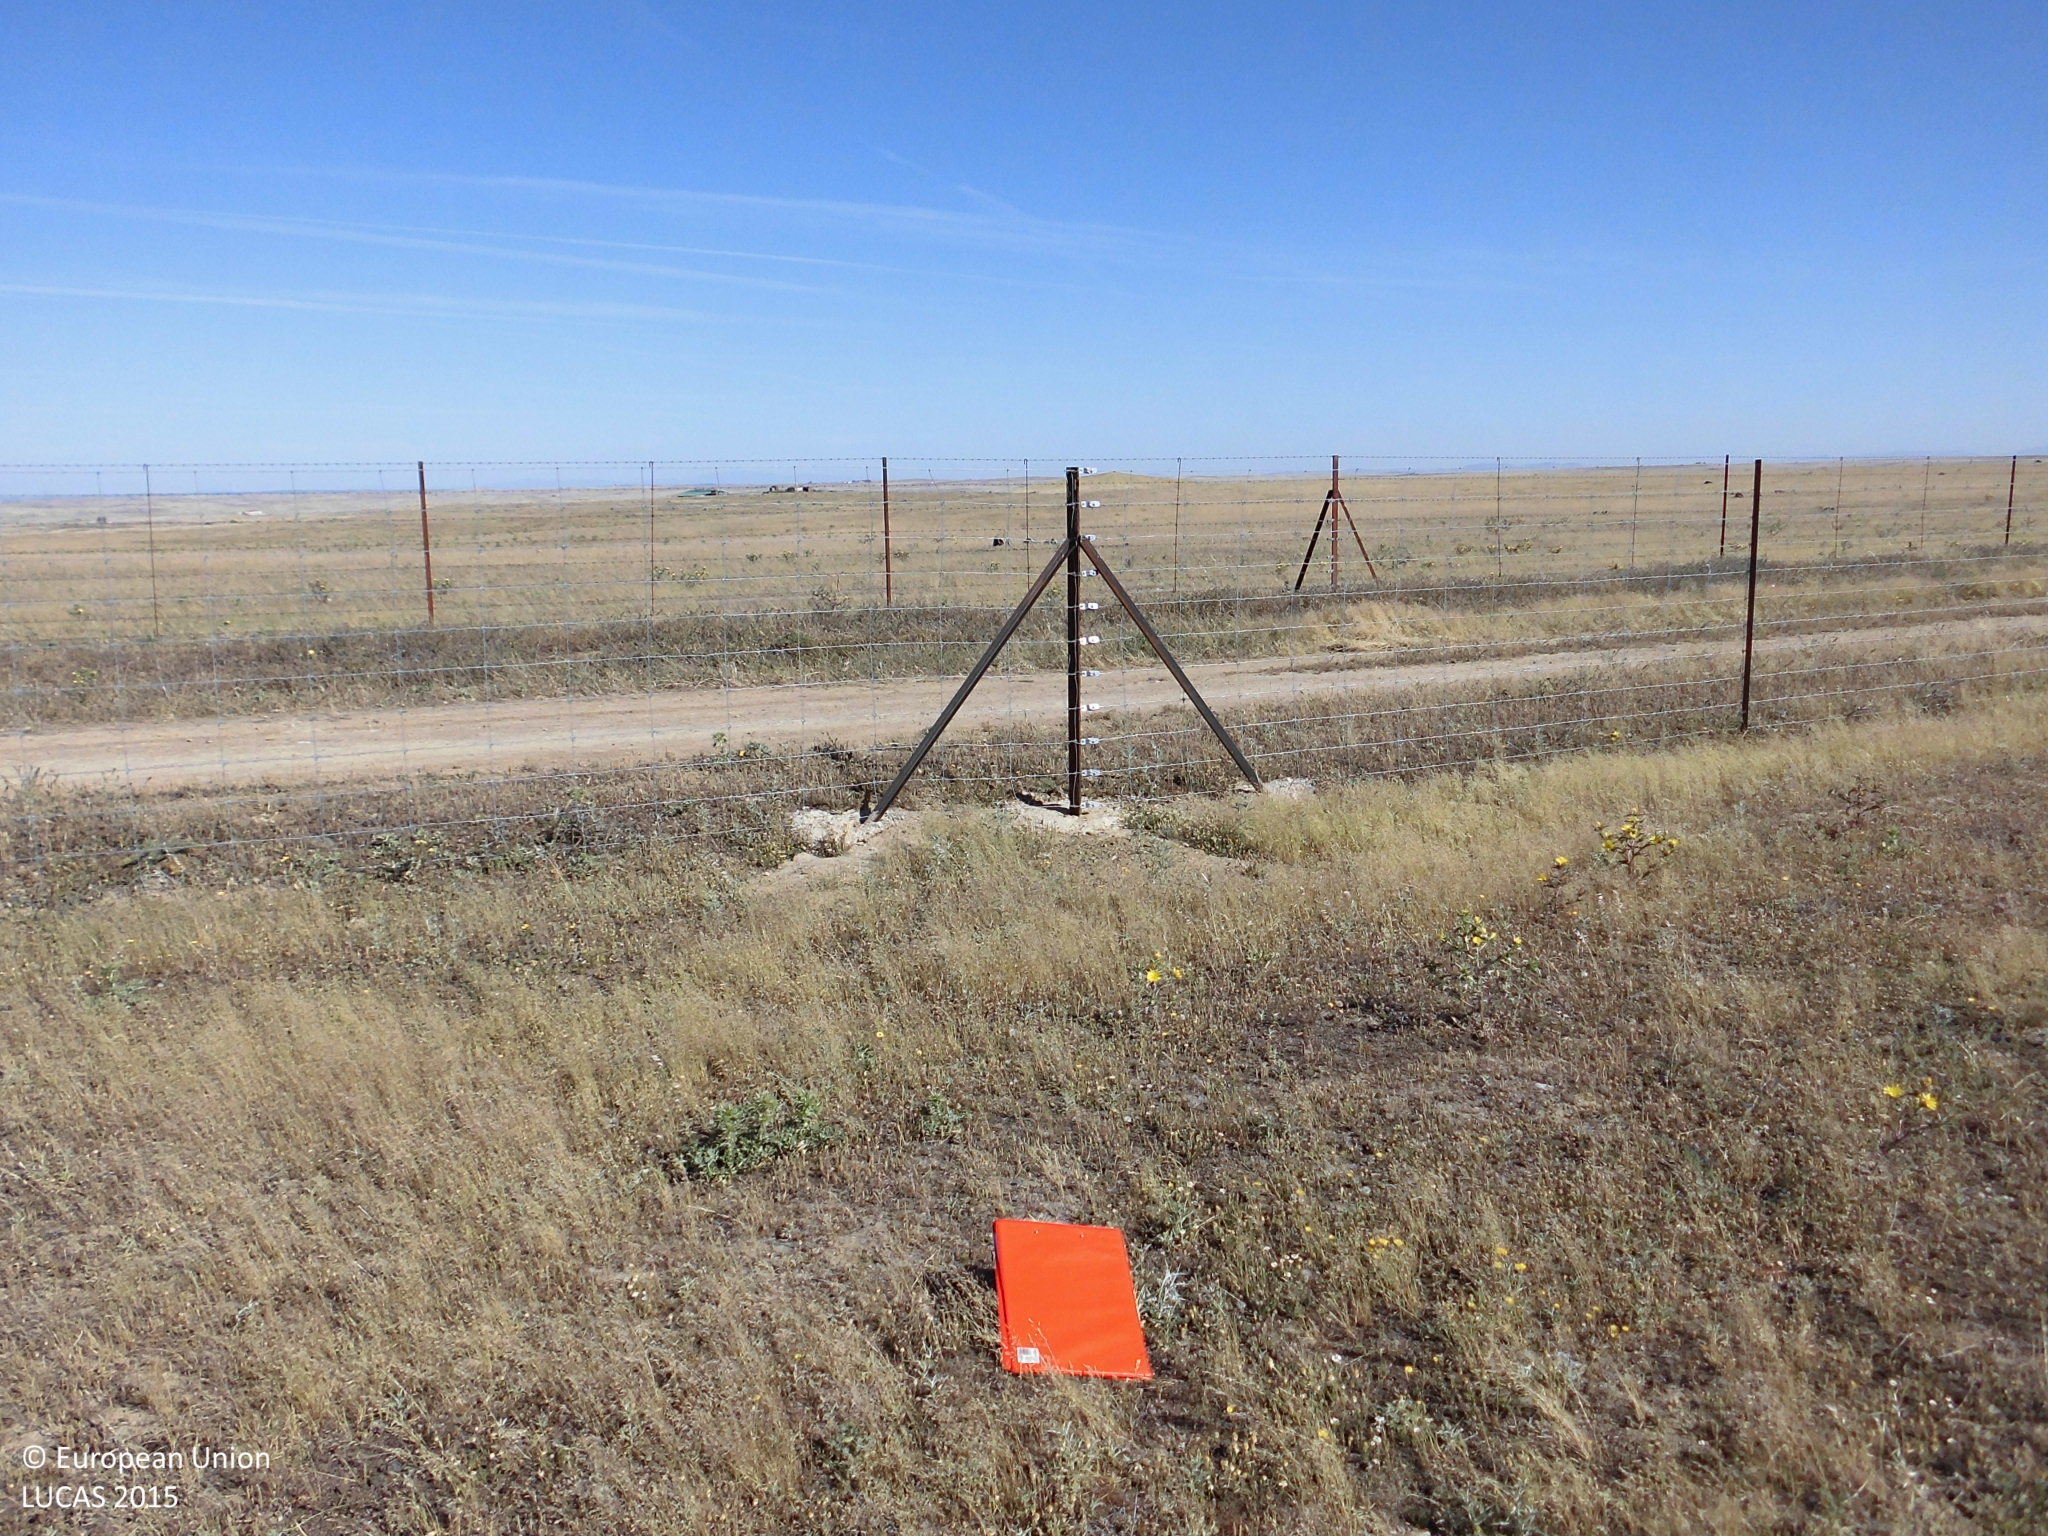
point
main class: Grassland
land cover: Grassland without tree/shrub cover
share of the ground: > 75 %
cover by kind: herbaceous plants 100 %
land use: Agriculture (excluding fallow land and kitchen gardens)
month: May
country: ES
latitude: 39.5364
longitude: -6.8450
